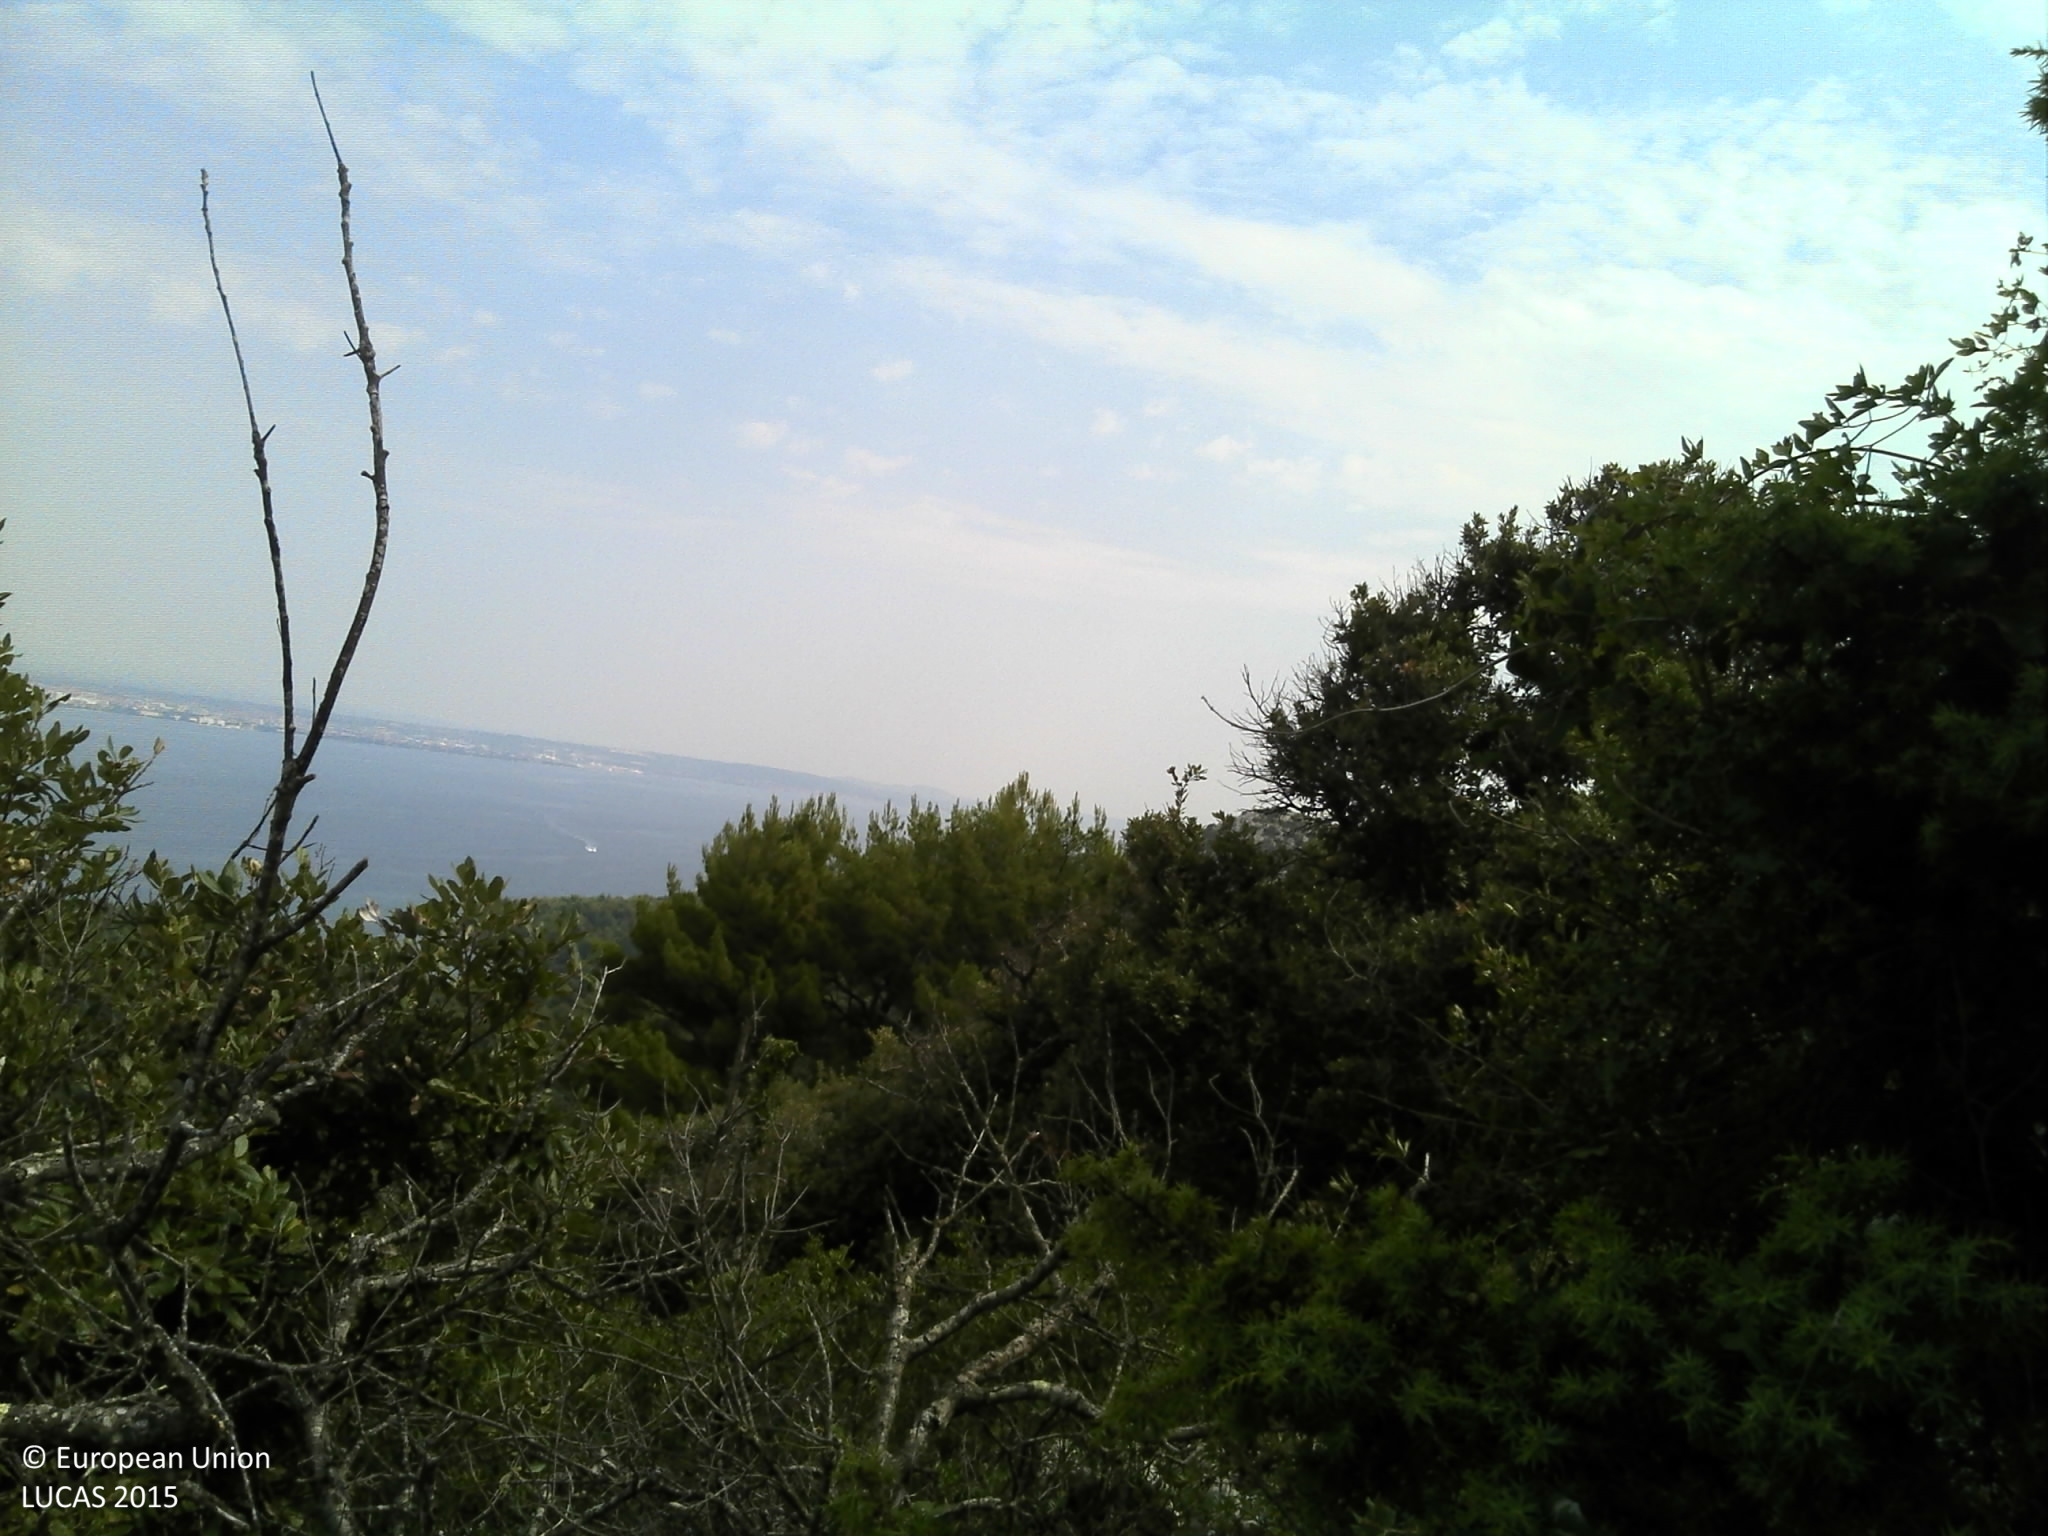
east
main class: Shrubland
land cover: Shrubland with sparse tree cover
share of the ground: > 75 %
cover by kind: shrubs 80 %, consolidated bare surface 10 %, broadleaved forest trees 5 %, herbaceous plants 5 %
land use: Semi-natural and natural areas not in use
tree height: < 5 m
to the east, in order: Shrubland with sparse tree cover; Rocks and stones; Shrubland with sparse tree cover; Pine dominated coniferous woodland; Shrubland with sparse tree cover
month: September
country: HR
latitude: 44.1154
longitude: 15.1274
